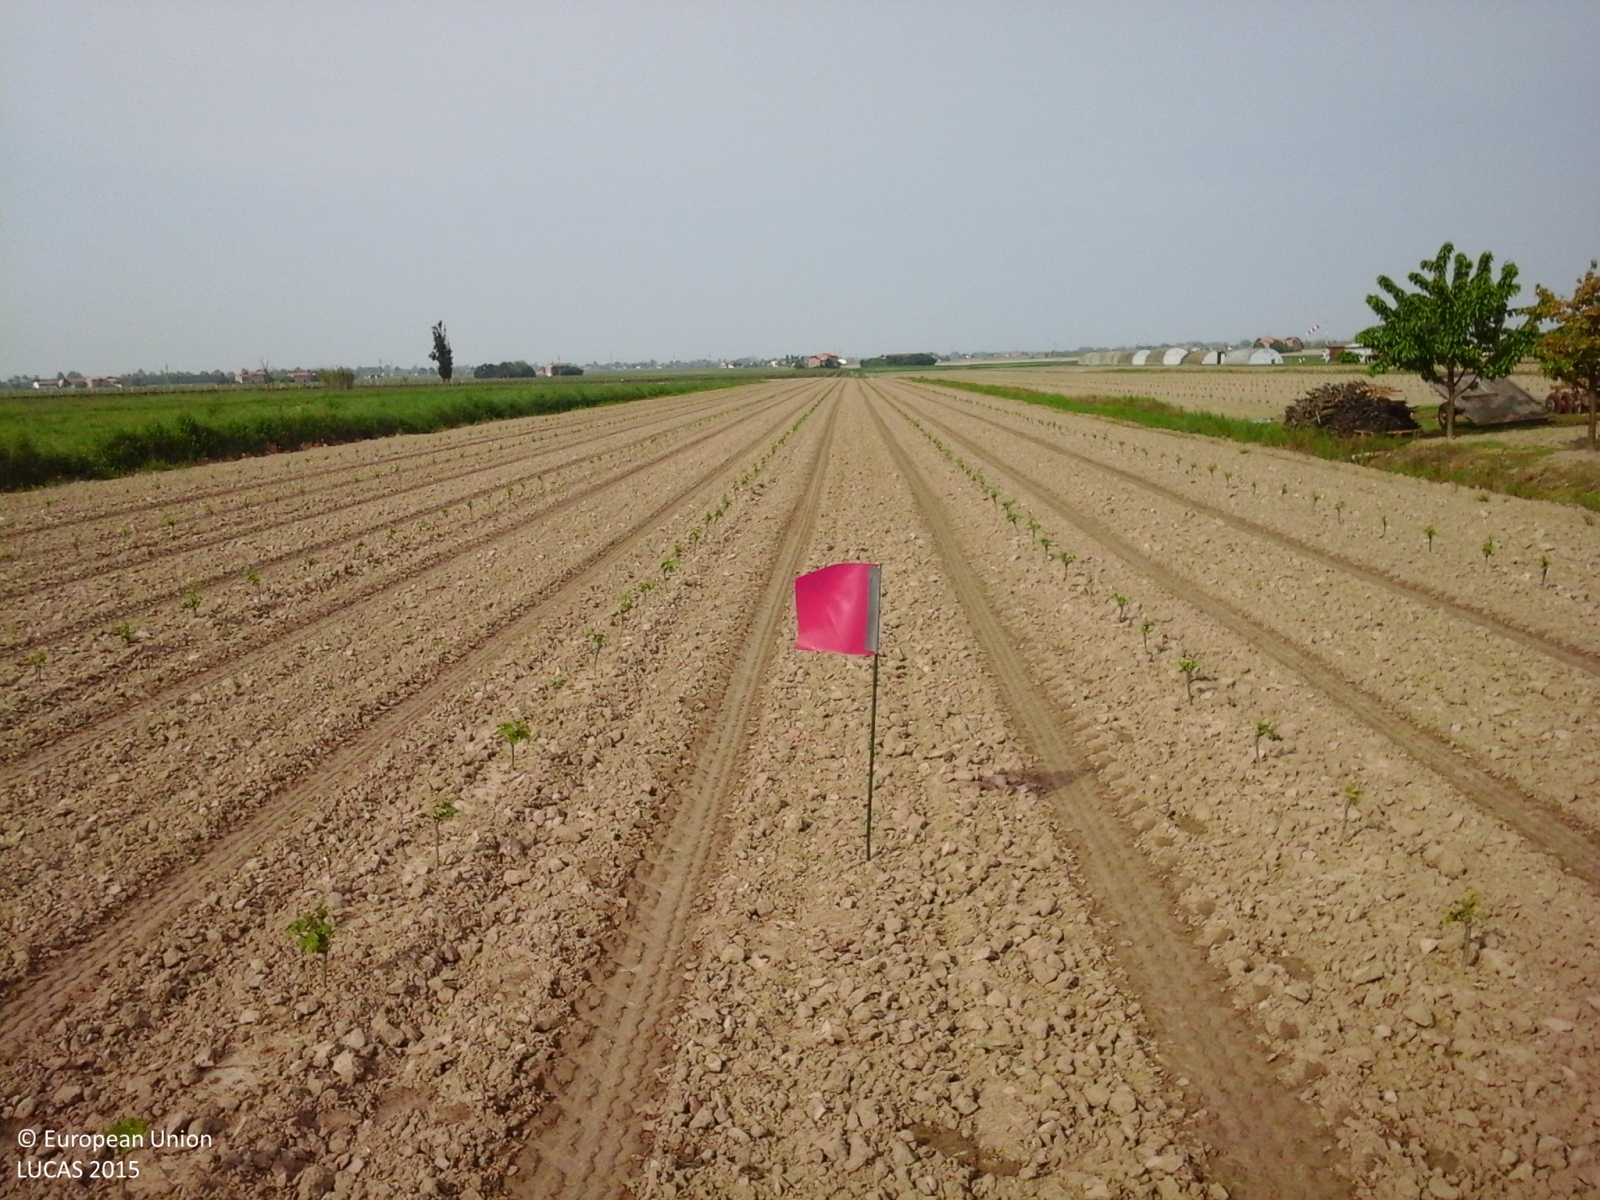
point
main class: Cropland
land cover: Vineyards
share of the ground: < 10 %
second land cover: Other bare soil
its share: > 75 %
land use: Agriculture (excluding fallow land and kitchen gardens)
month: May
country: IT
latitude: 45.5633
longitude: 12.5714
